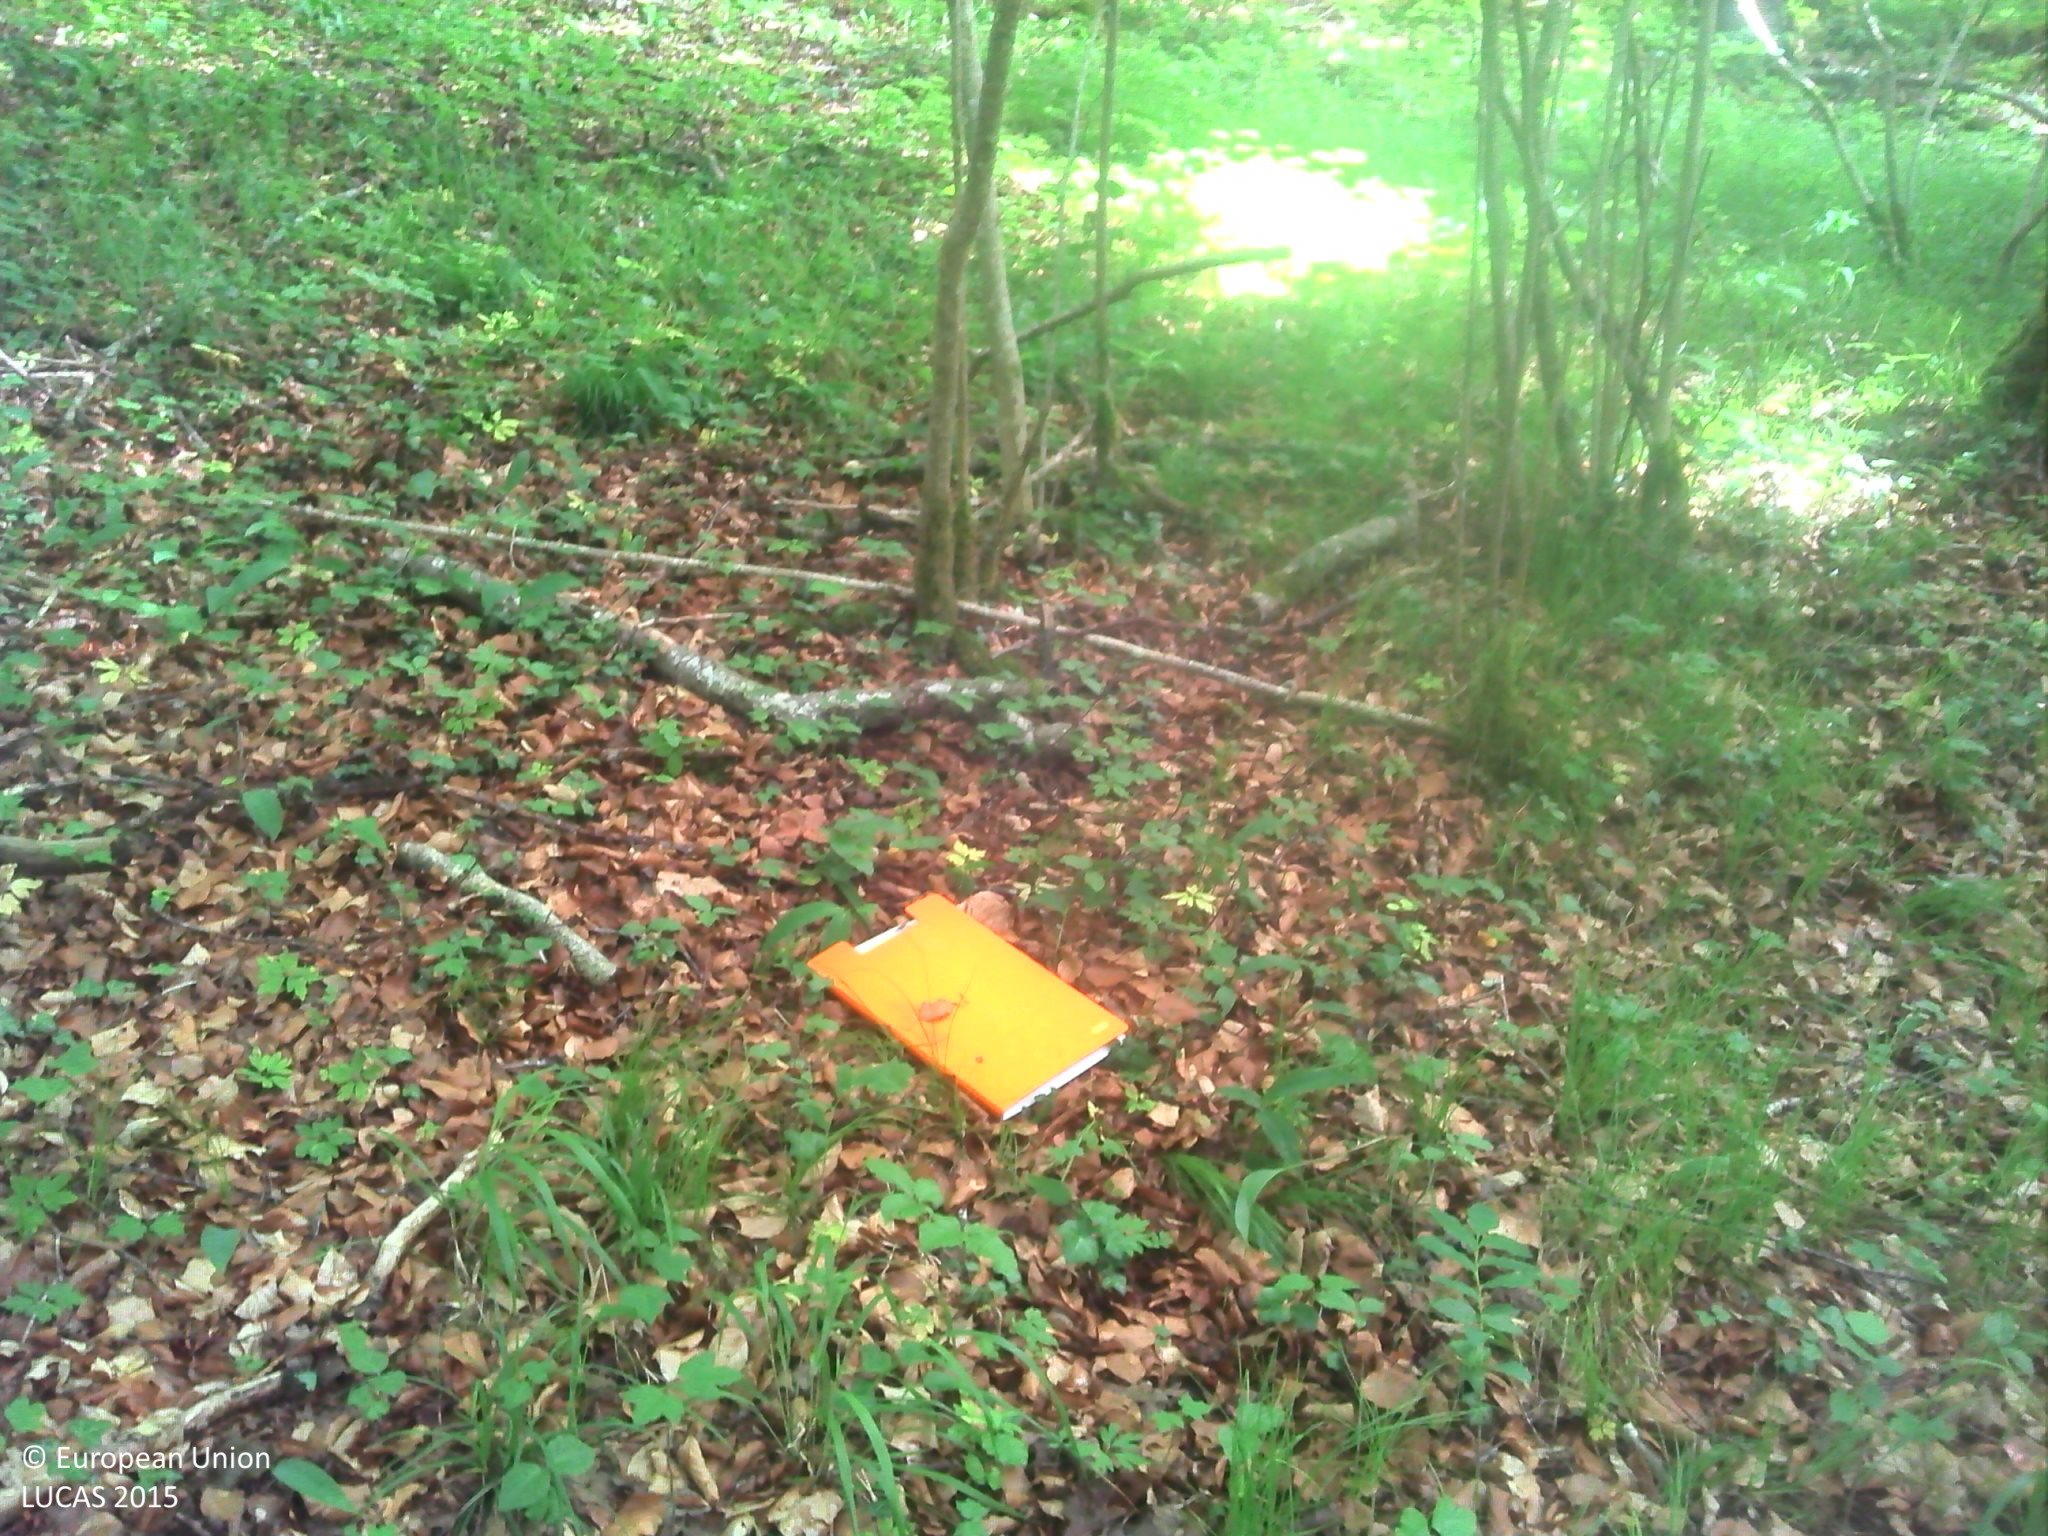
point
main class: Woodland
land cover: Broadleaved woodland
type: beech forest
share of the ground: > 75 %
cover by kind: broadleaved forest trees 80 %, coniferous forest trees 10 %, herbaceous plants 5 %, lichens and mosses 5 %
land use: Forestry
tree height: > 5 m
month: June
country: FR
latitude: 48.3167
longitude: 5.1848
